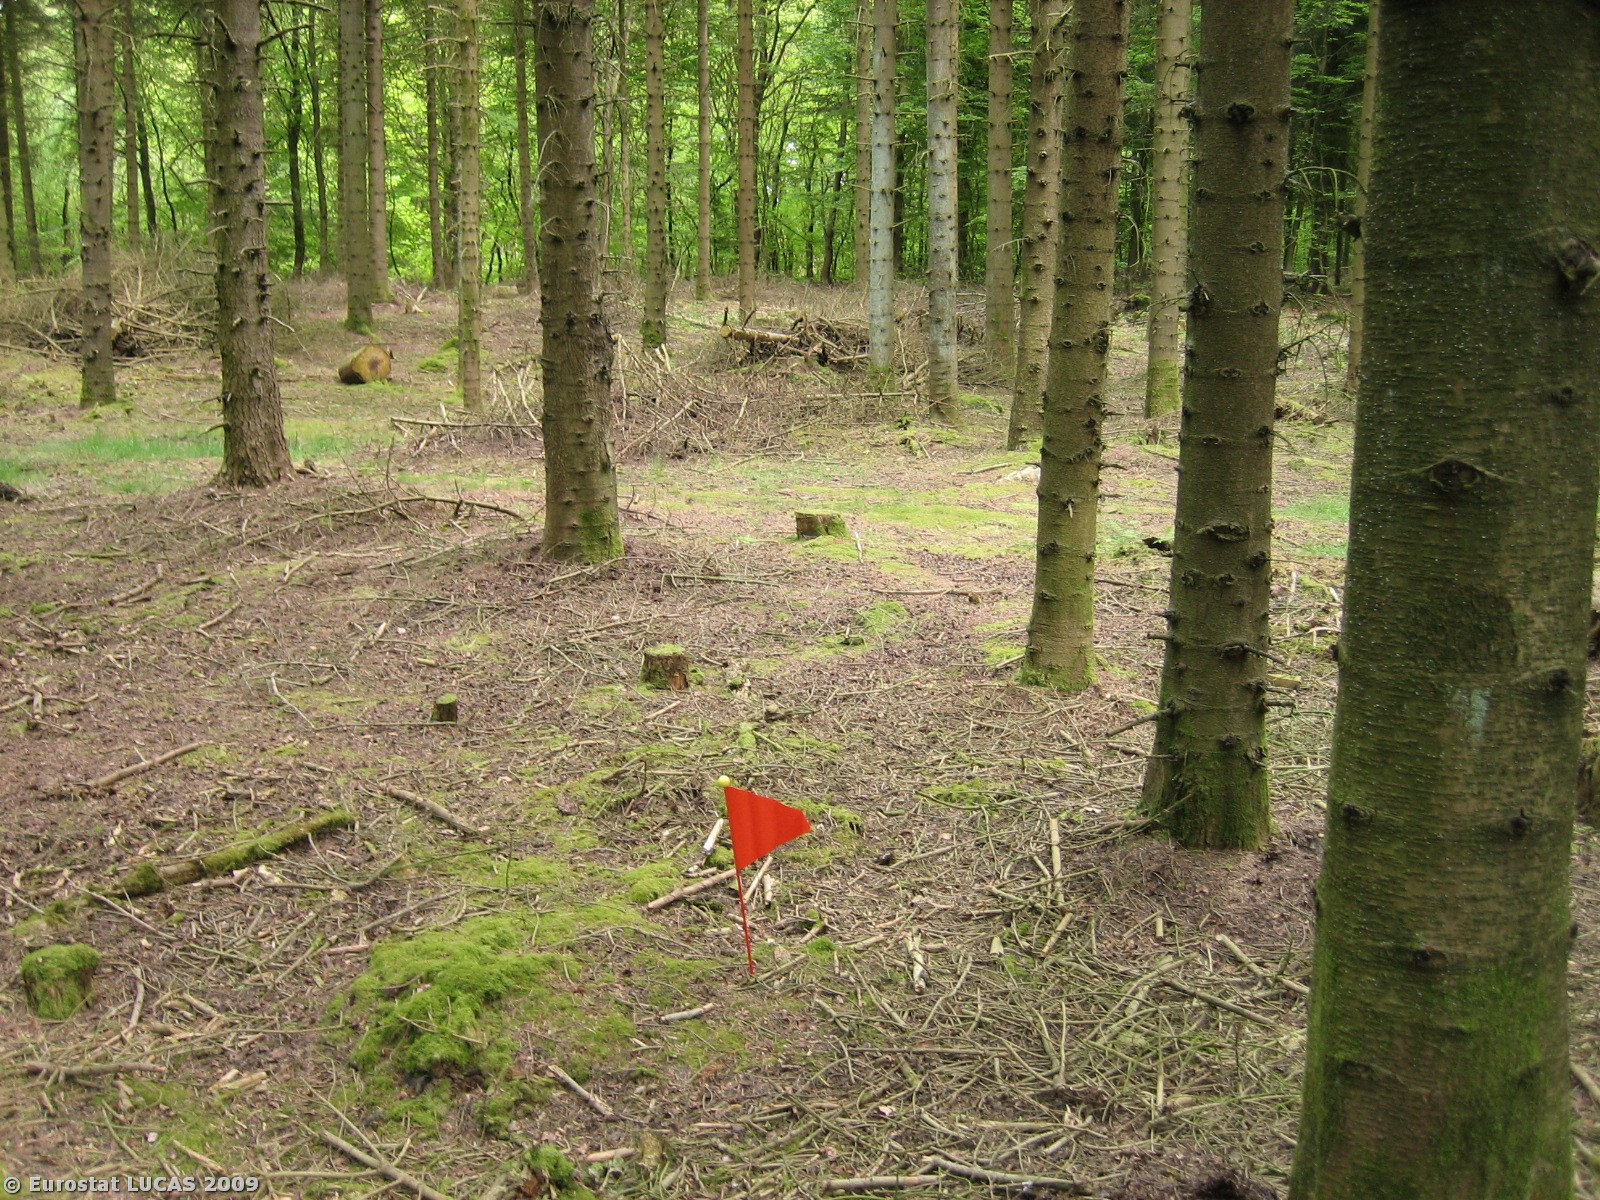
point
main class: Woodland
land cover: Coniferous woodland
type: hemiboreal forest and nemoral coniferous forest and mixed broadleaved-coniferous forest
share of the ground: > 75 %
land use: Forestry
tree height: > 5 m
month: May
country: DK
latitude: 56.1599
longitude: 8.4077
